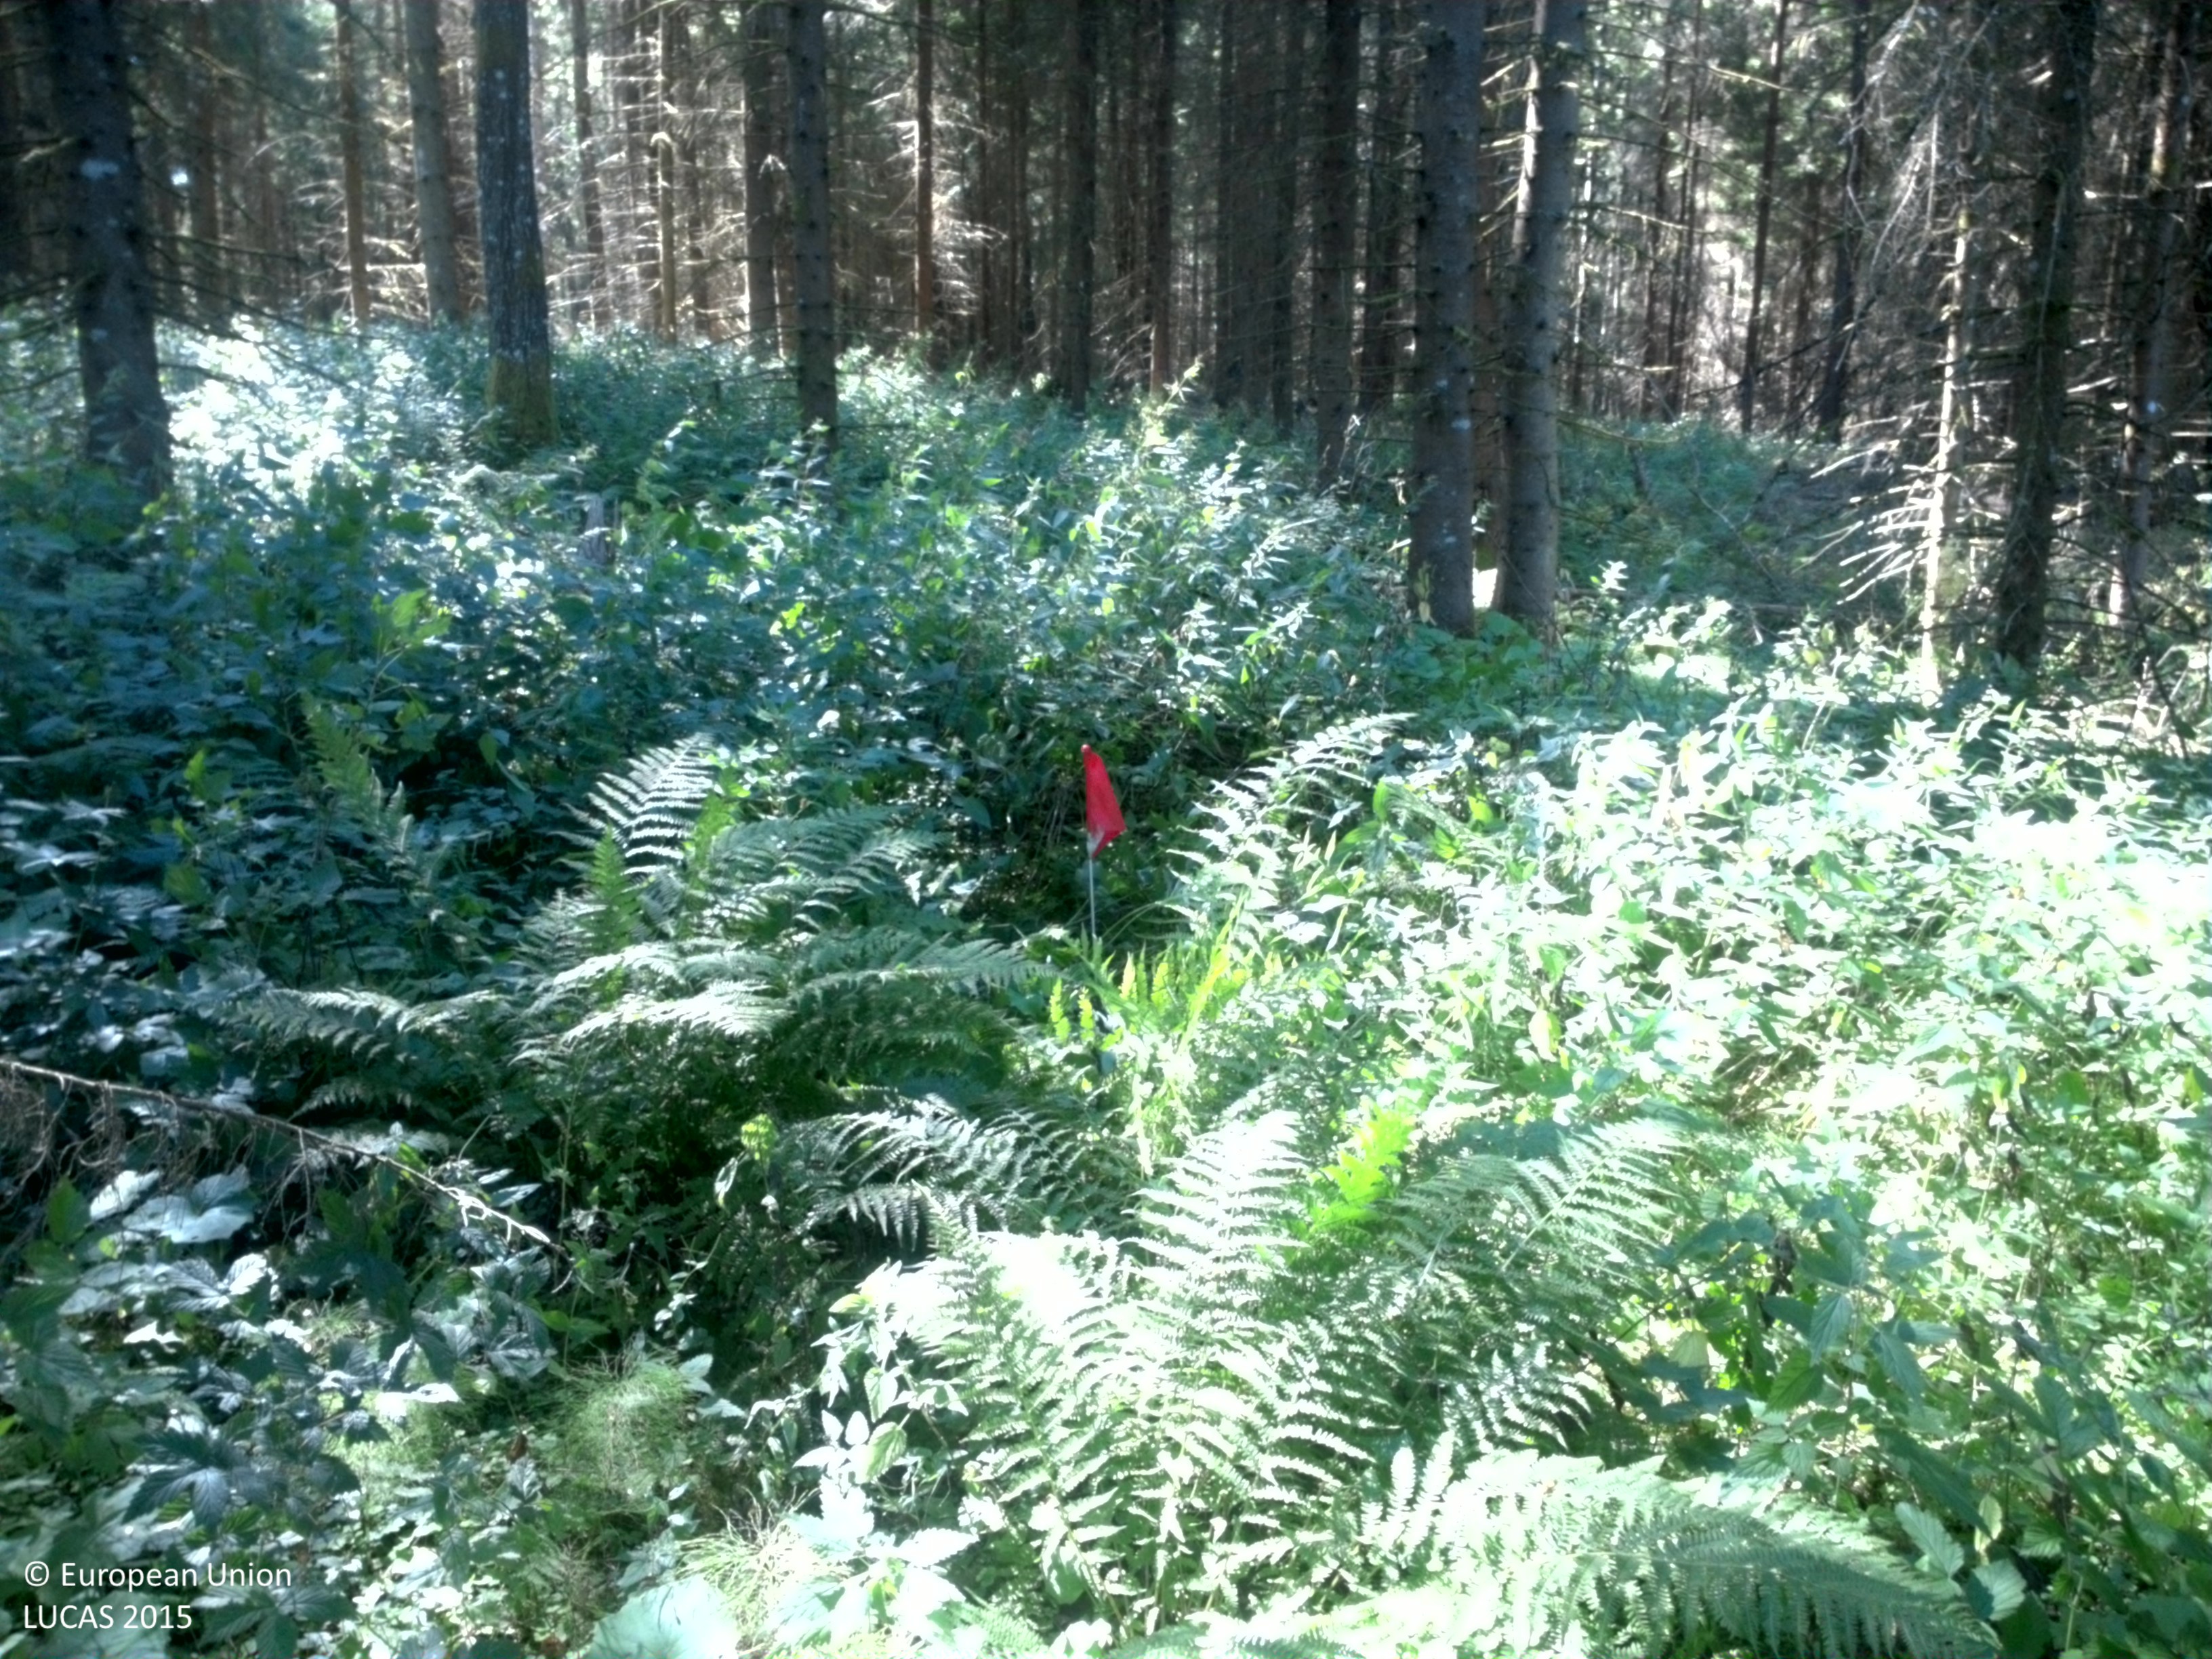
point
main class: Woodland
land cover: Spruce dominated coniferous woodland
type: boreal forest
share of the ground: 50 - 75 %
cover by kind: coniferous forest trees 55 %, herbaceous plants 30 %, lichens and mosses 10 %, broadleaved forest trees 5 %
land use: Forestry
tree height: > 5 m
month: August
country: SE
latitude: 57.9992
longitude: 13.2941
